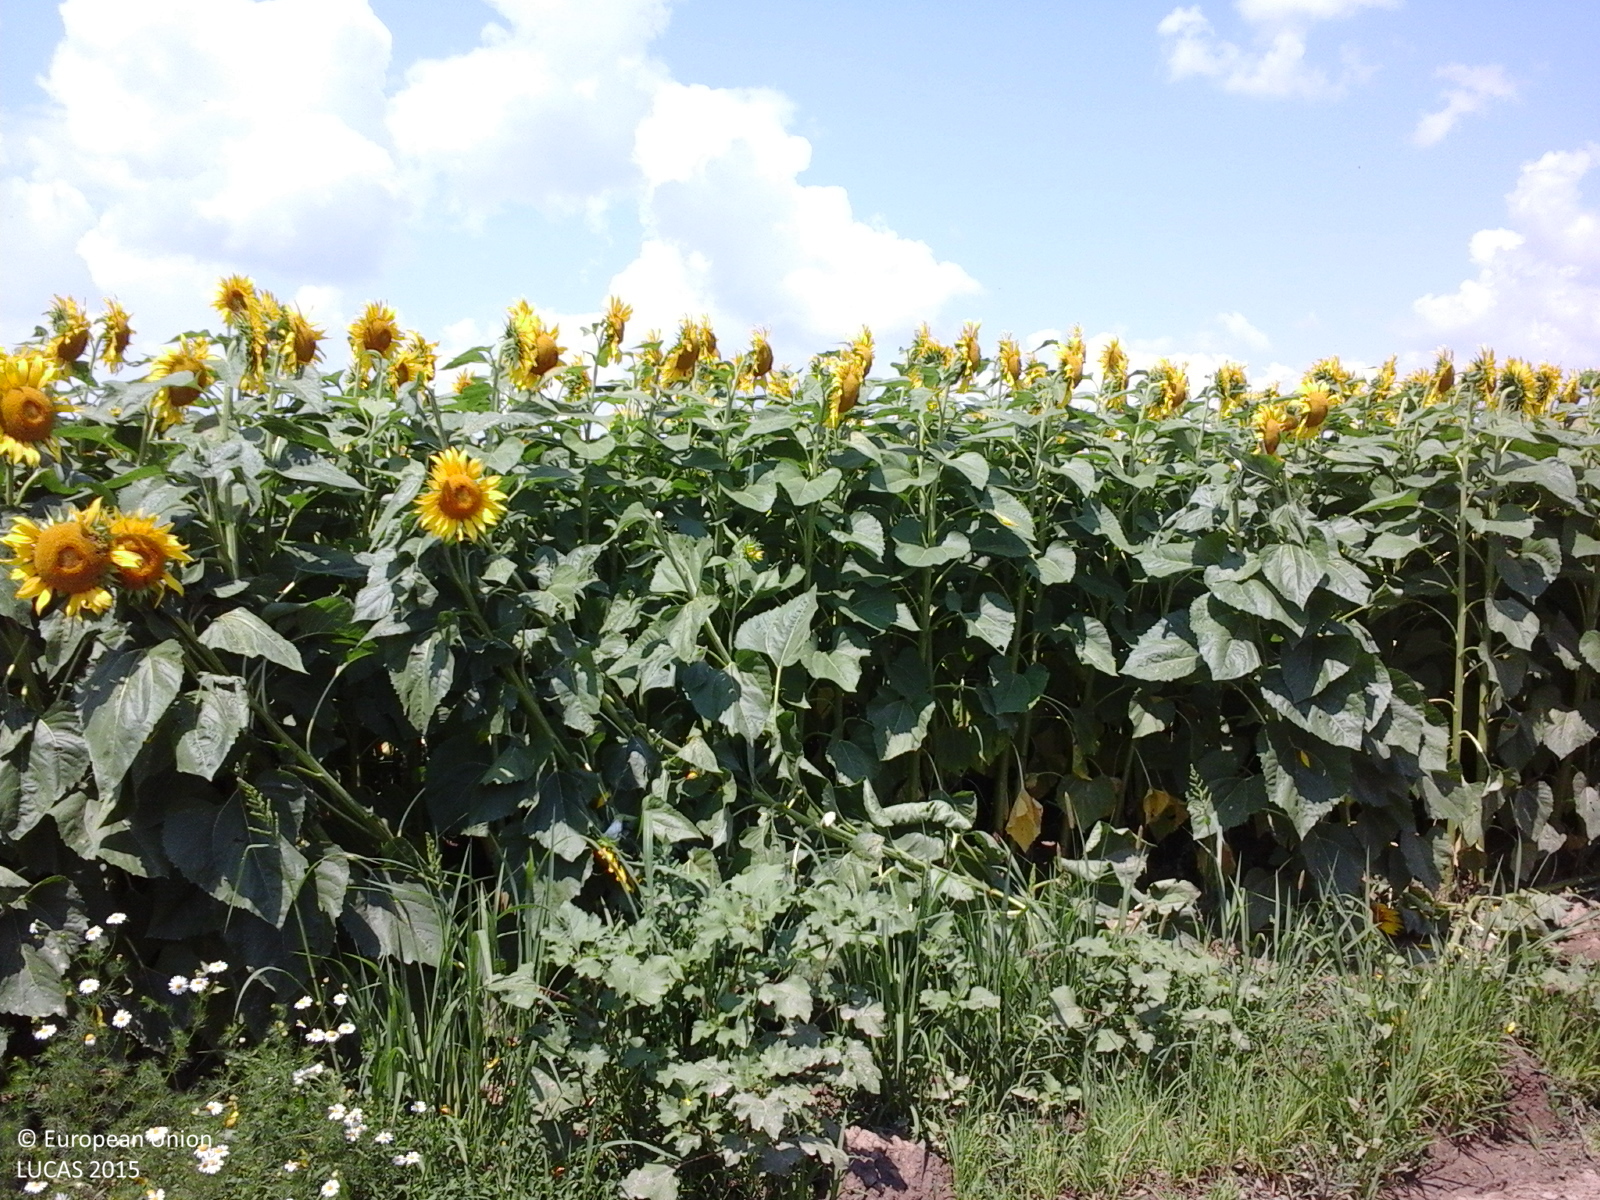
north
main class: Cropland
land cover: Sunflower
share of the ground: > 75 %
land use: Agriculture (excluding fallow land and kitchen gardens)
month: July
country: RO
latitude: 43.6485
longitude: 25.4176
